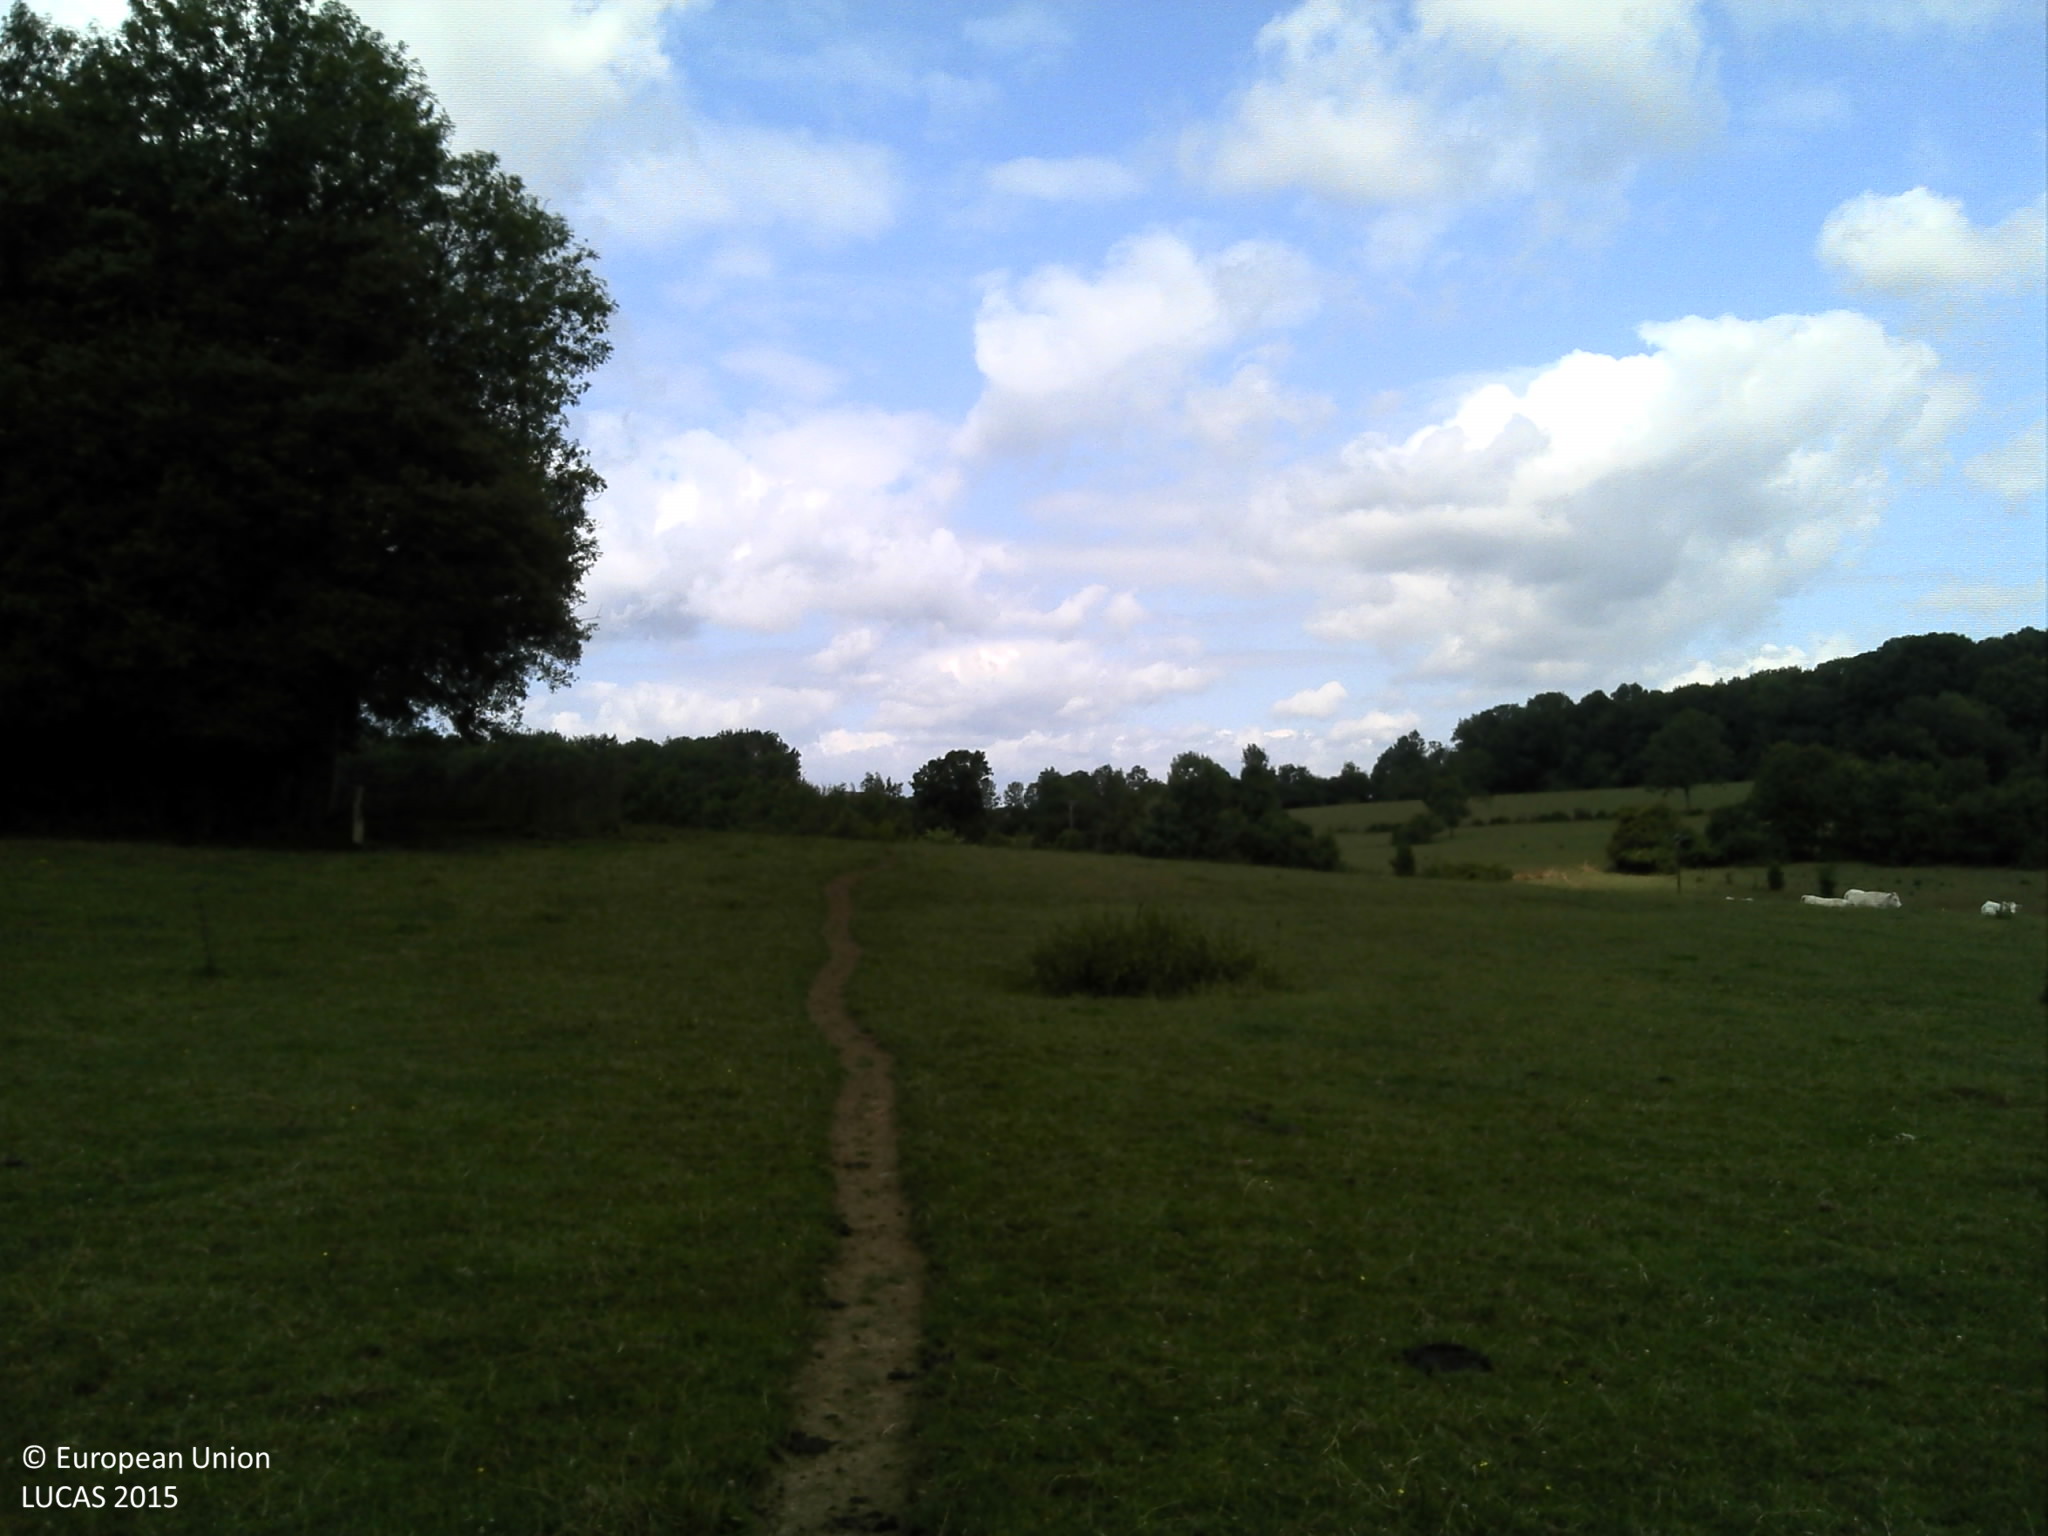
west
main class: Grassland
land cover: Grassland without tree/shrub cover
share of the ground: > 75 %
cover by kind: herbaceous plants 100 %
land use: Agriculture (excluding fallow land and kitchen gardens)
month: July
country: FR
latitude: 49.7073
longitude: 4.4632
